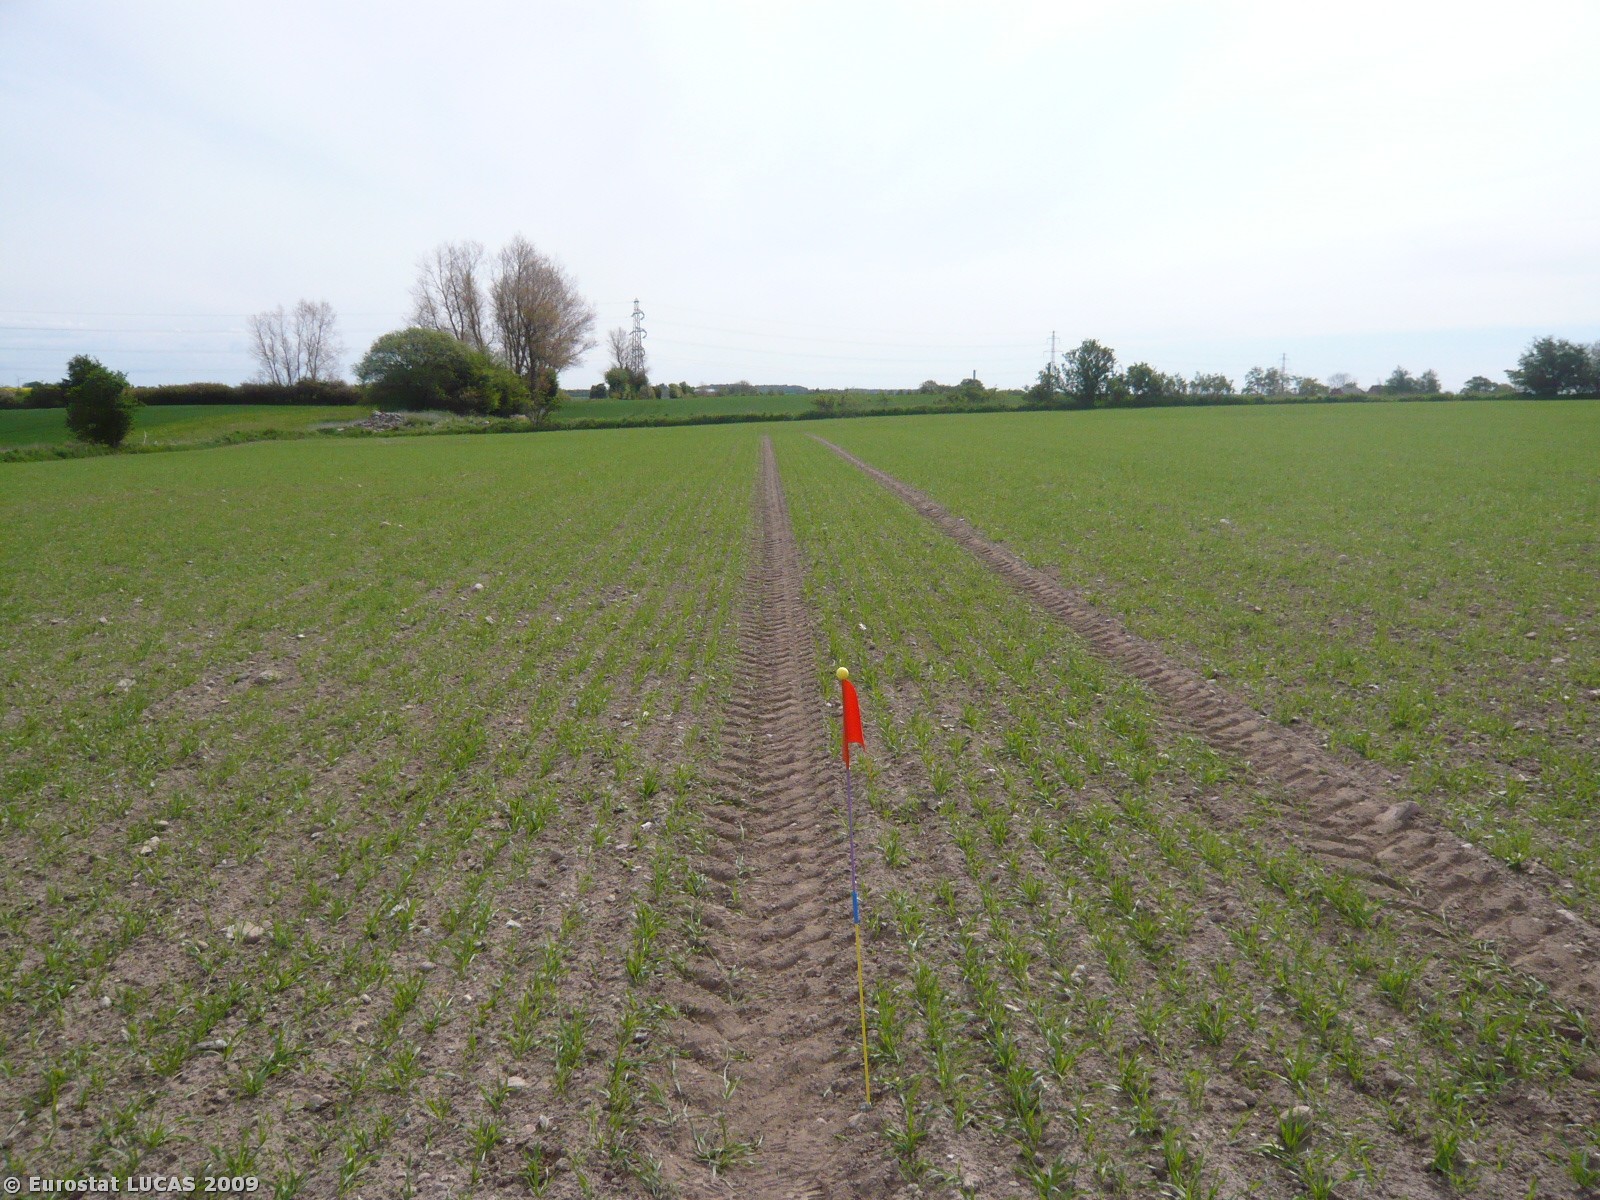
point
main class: Cropland
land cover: Common wheat
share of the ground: 25 - 50 %
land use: Agriculture (excluding fallow land and kitchen gardens)
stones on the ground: 10 - 25 %
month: May
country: DK
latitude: 55.1489
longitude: 11.8973
